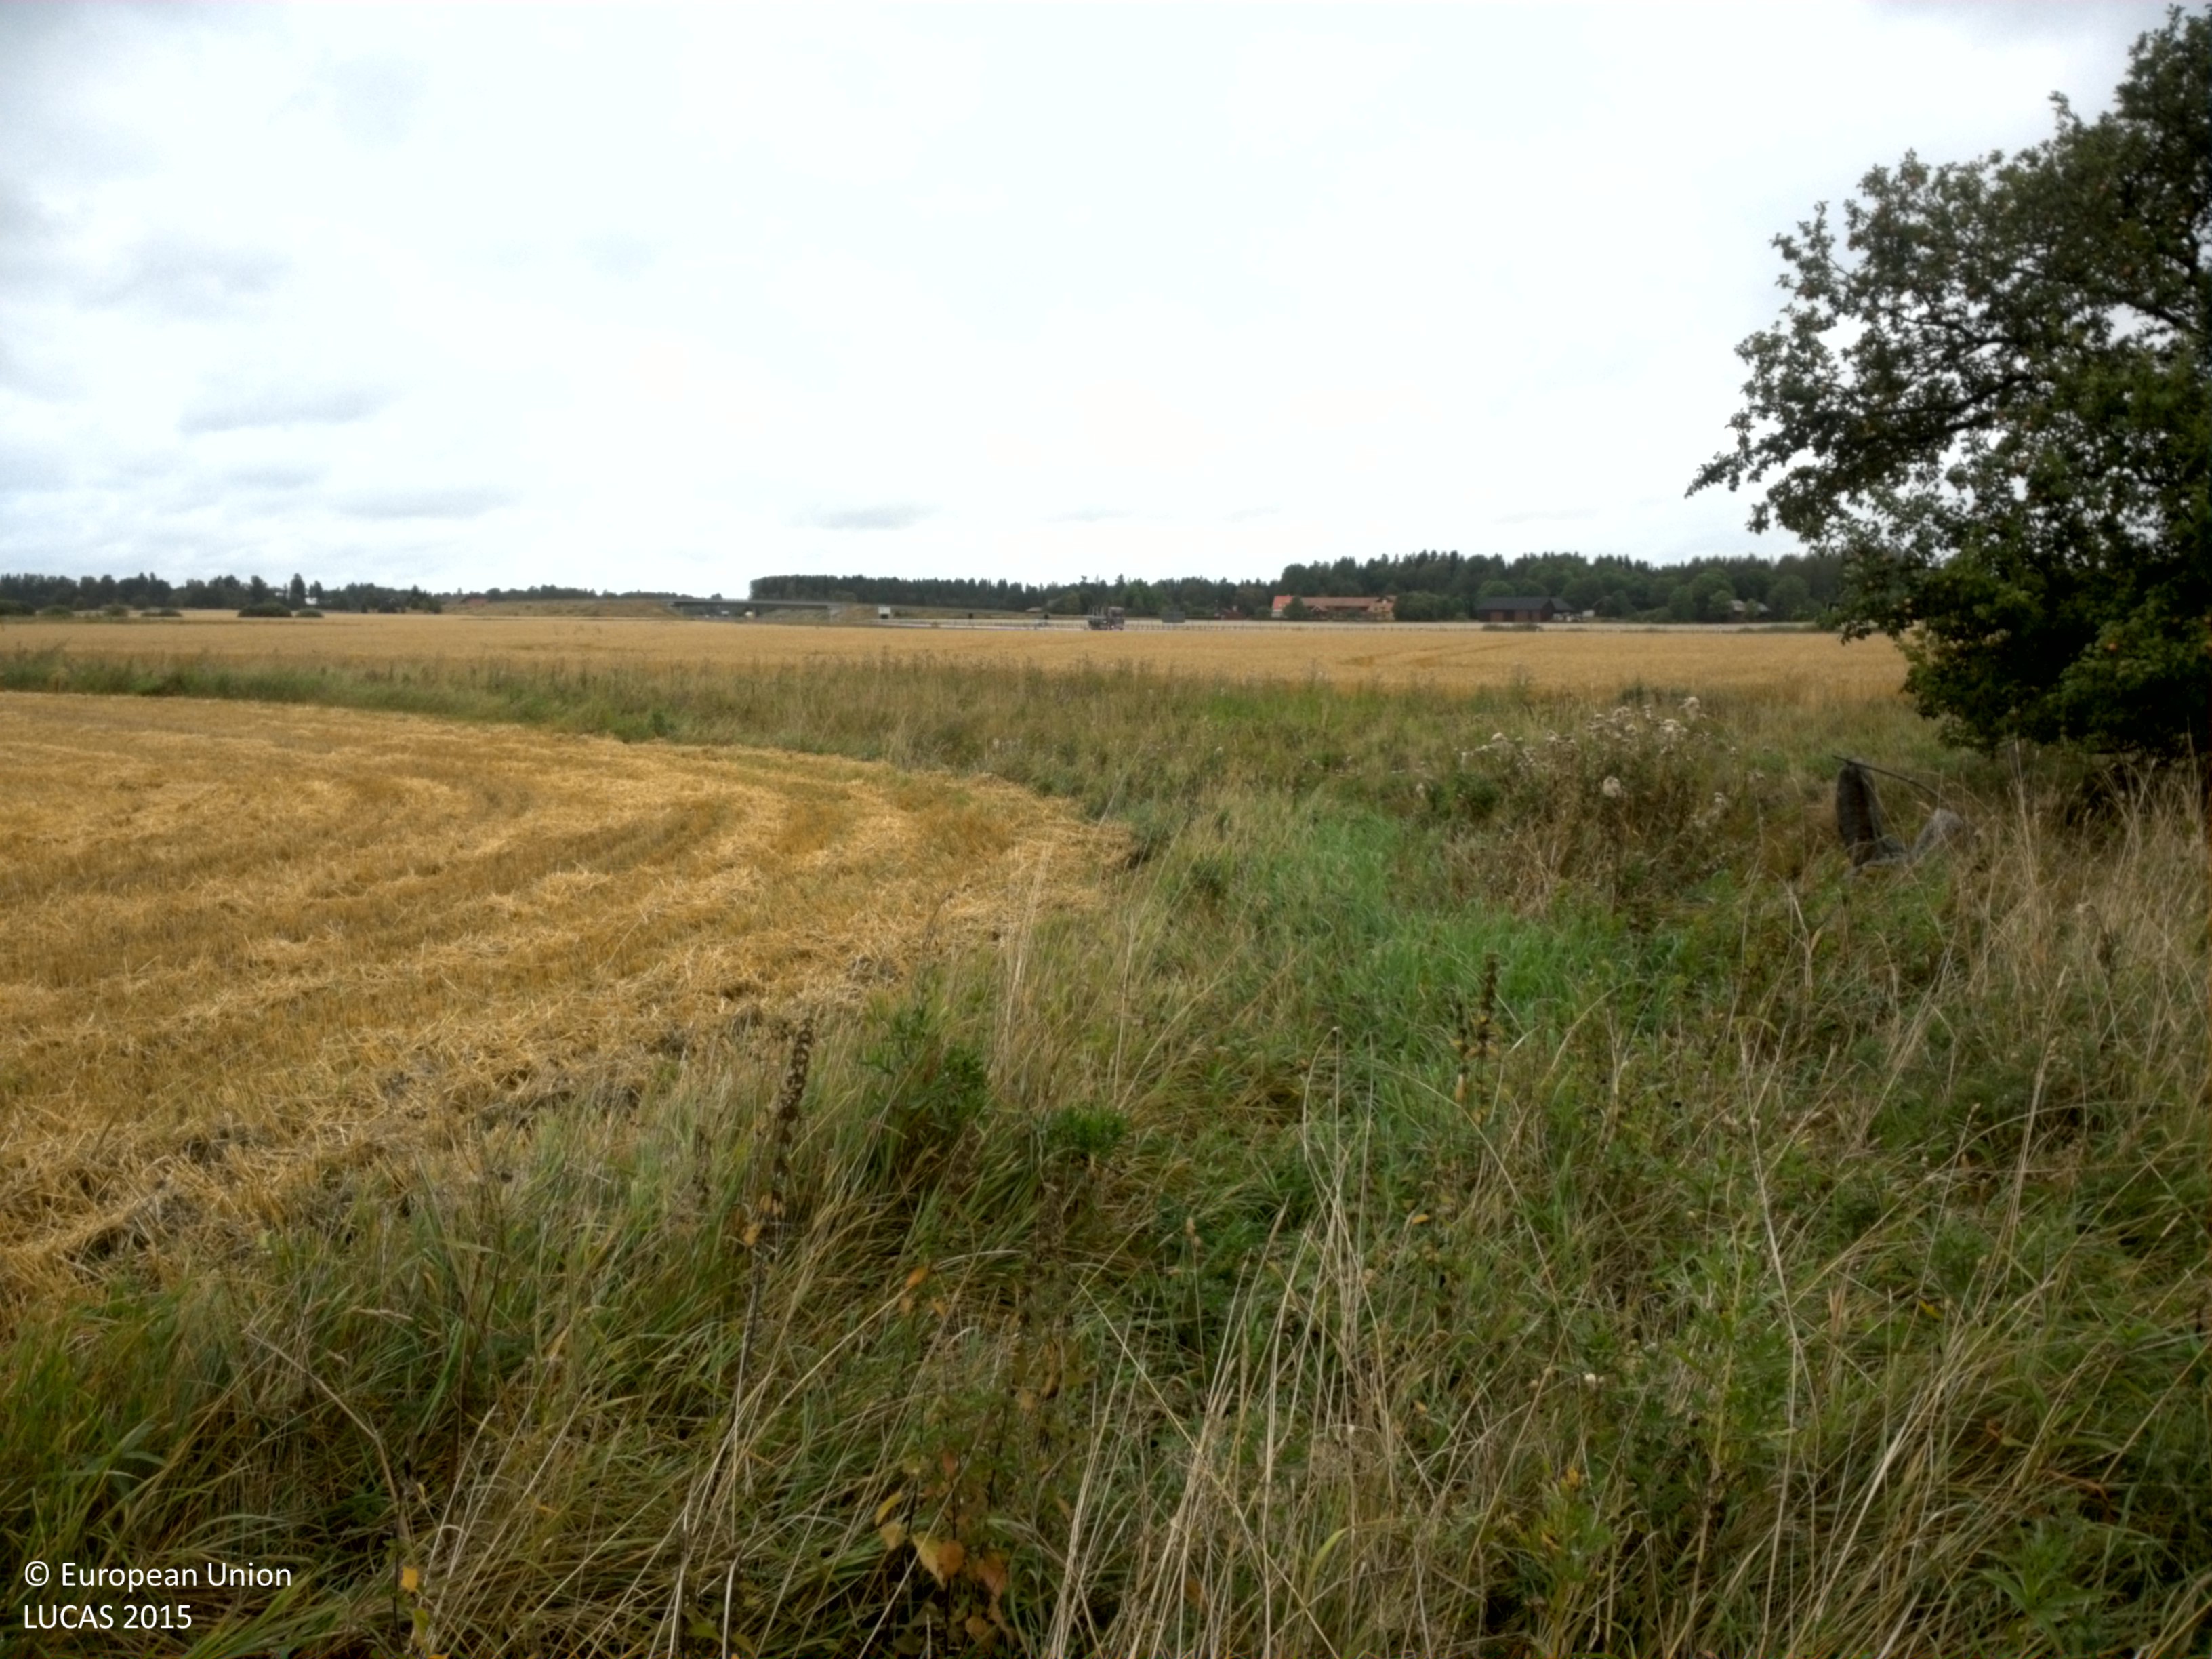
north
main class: Grassland
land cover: Grassland without tree/shrub cover
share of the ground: > 75 %
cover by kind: herbaceous plants 100 %
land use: Agriculture (excluding fallow land and kitchen gardens)
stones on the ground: < 10 %
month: August
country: SE
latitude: 59.9732
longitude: 17.6439
